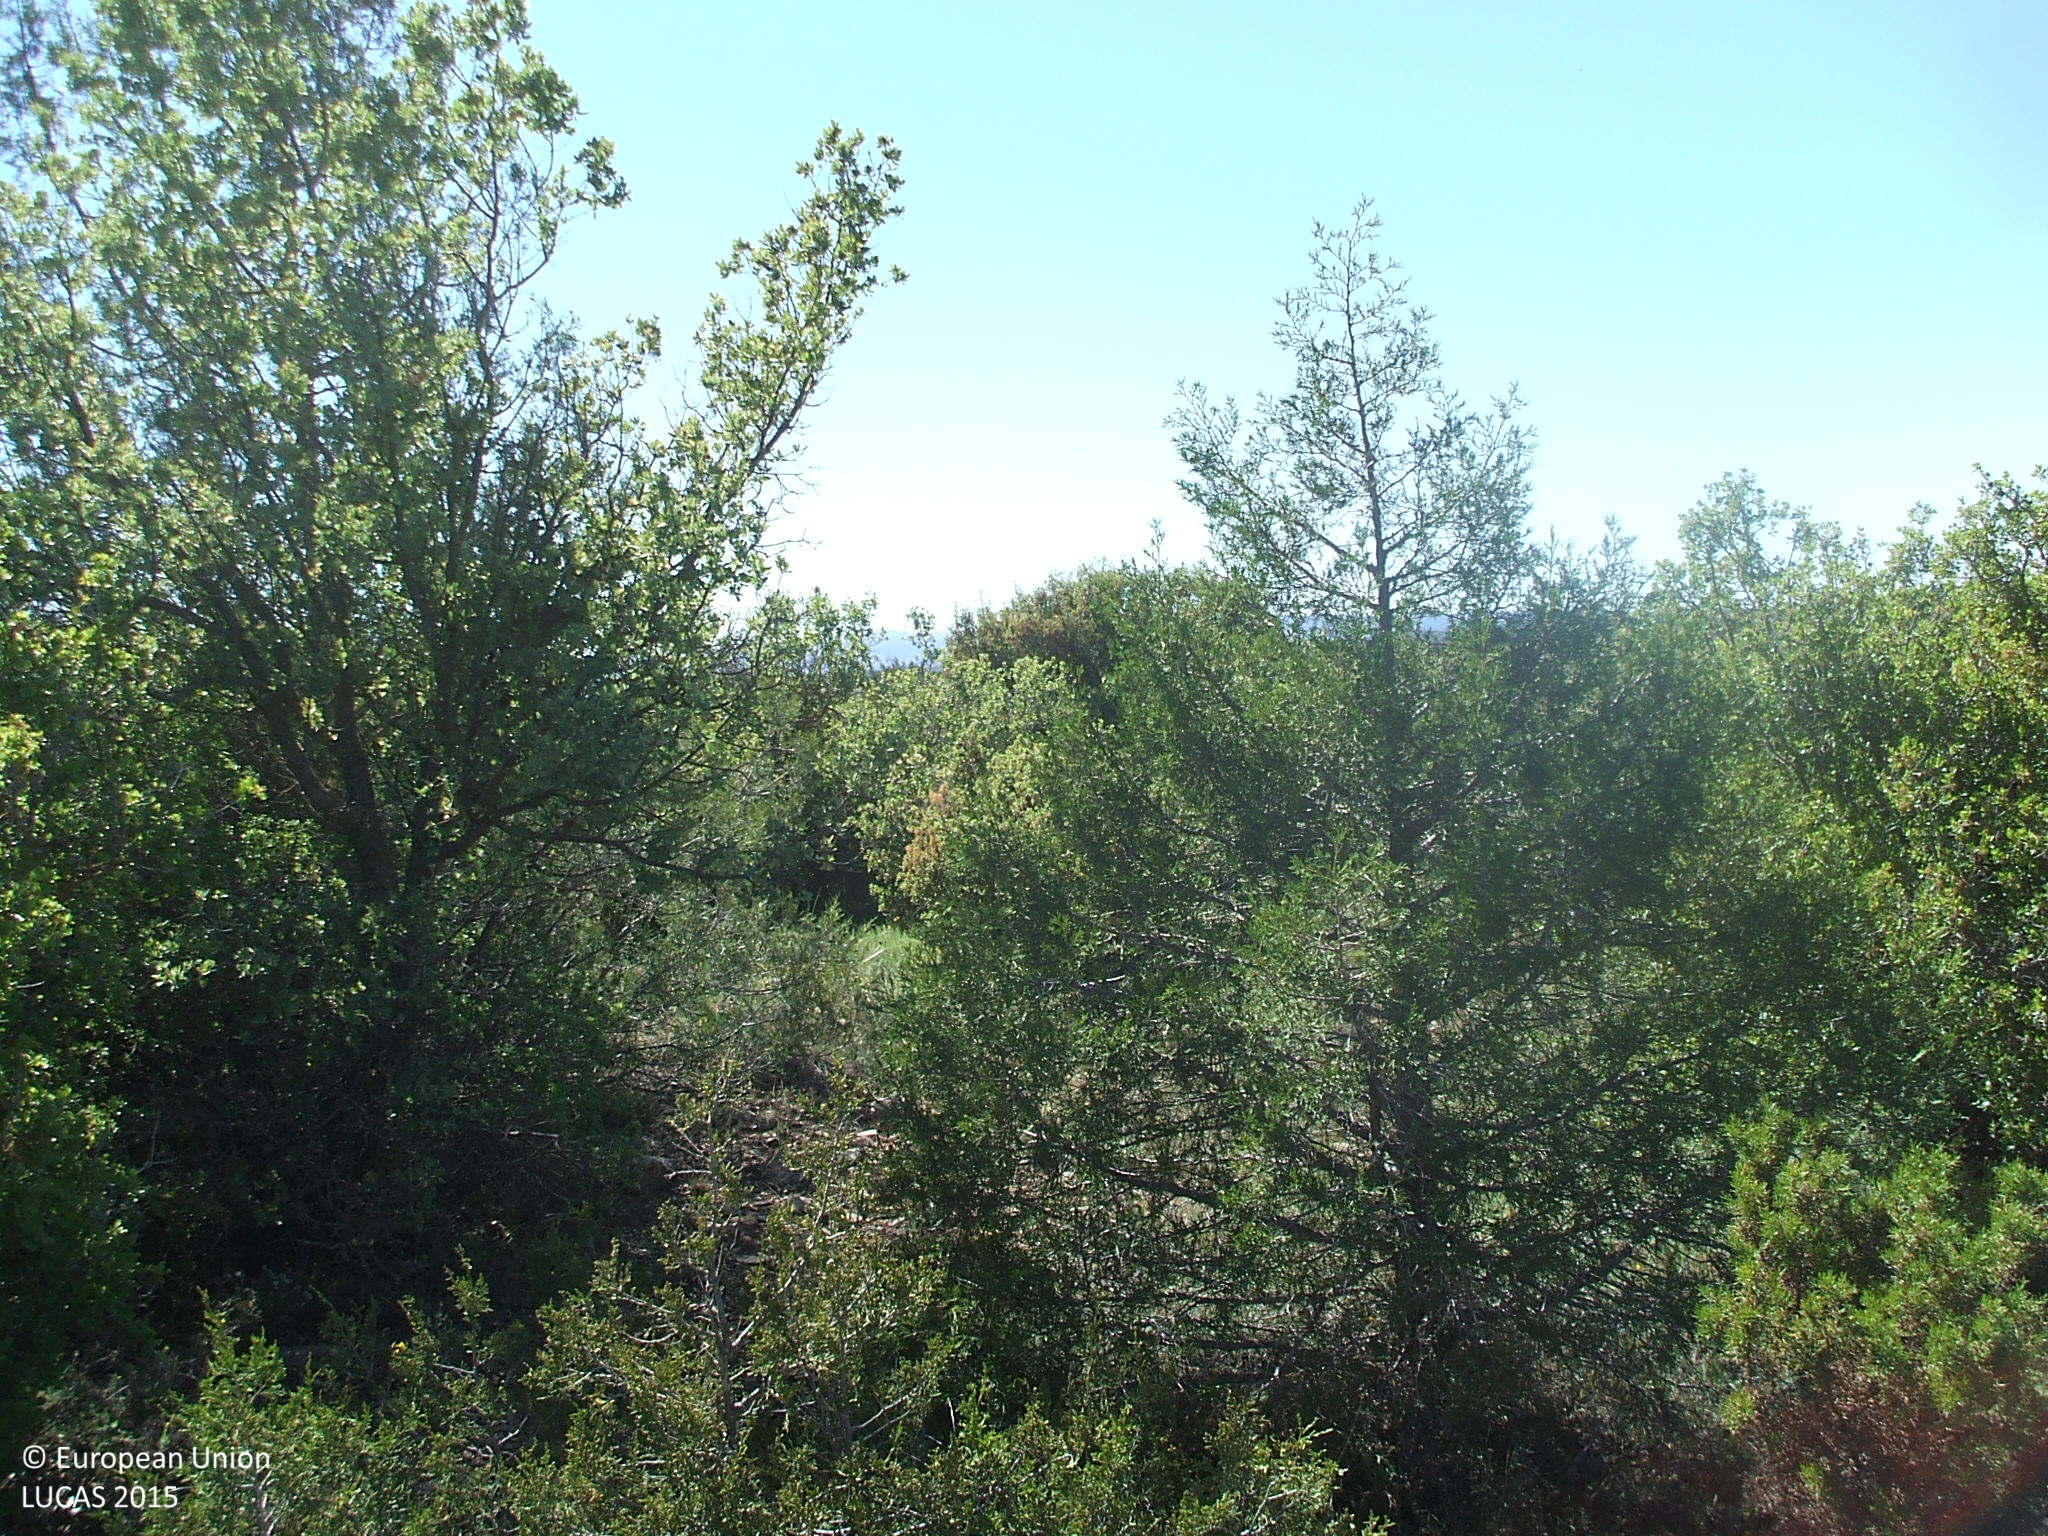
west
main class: Woodland
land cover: Other mixed woodland
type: coniferous forest of the mediterranean region
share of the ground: 25 - 50 %
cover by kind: herbaceous plants 40 %, unconsolidated bare surface 25 %, coniferous forest trees 15 %, broadleaved forest trees 15 %, shrubs 5 %
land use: Semi-natural and natural areas not in use
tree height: < 5 m
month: May
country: ES
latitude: 40.0445
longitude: -0.7061
